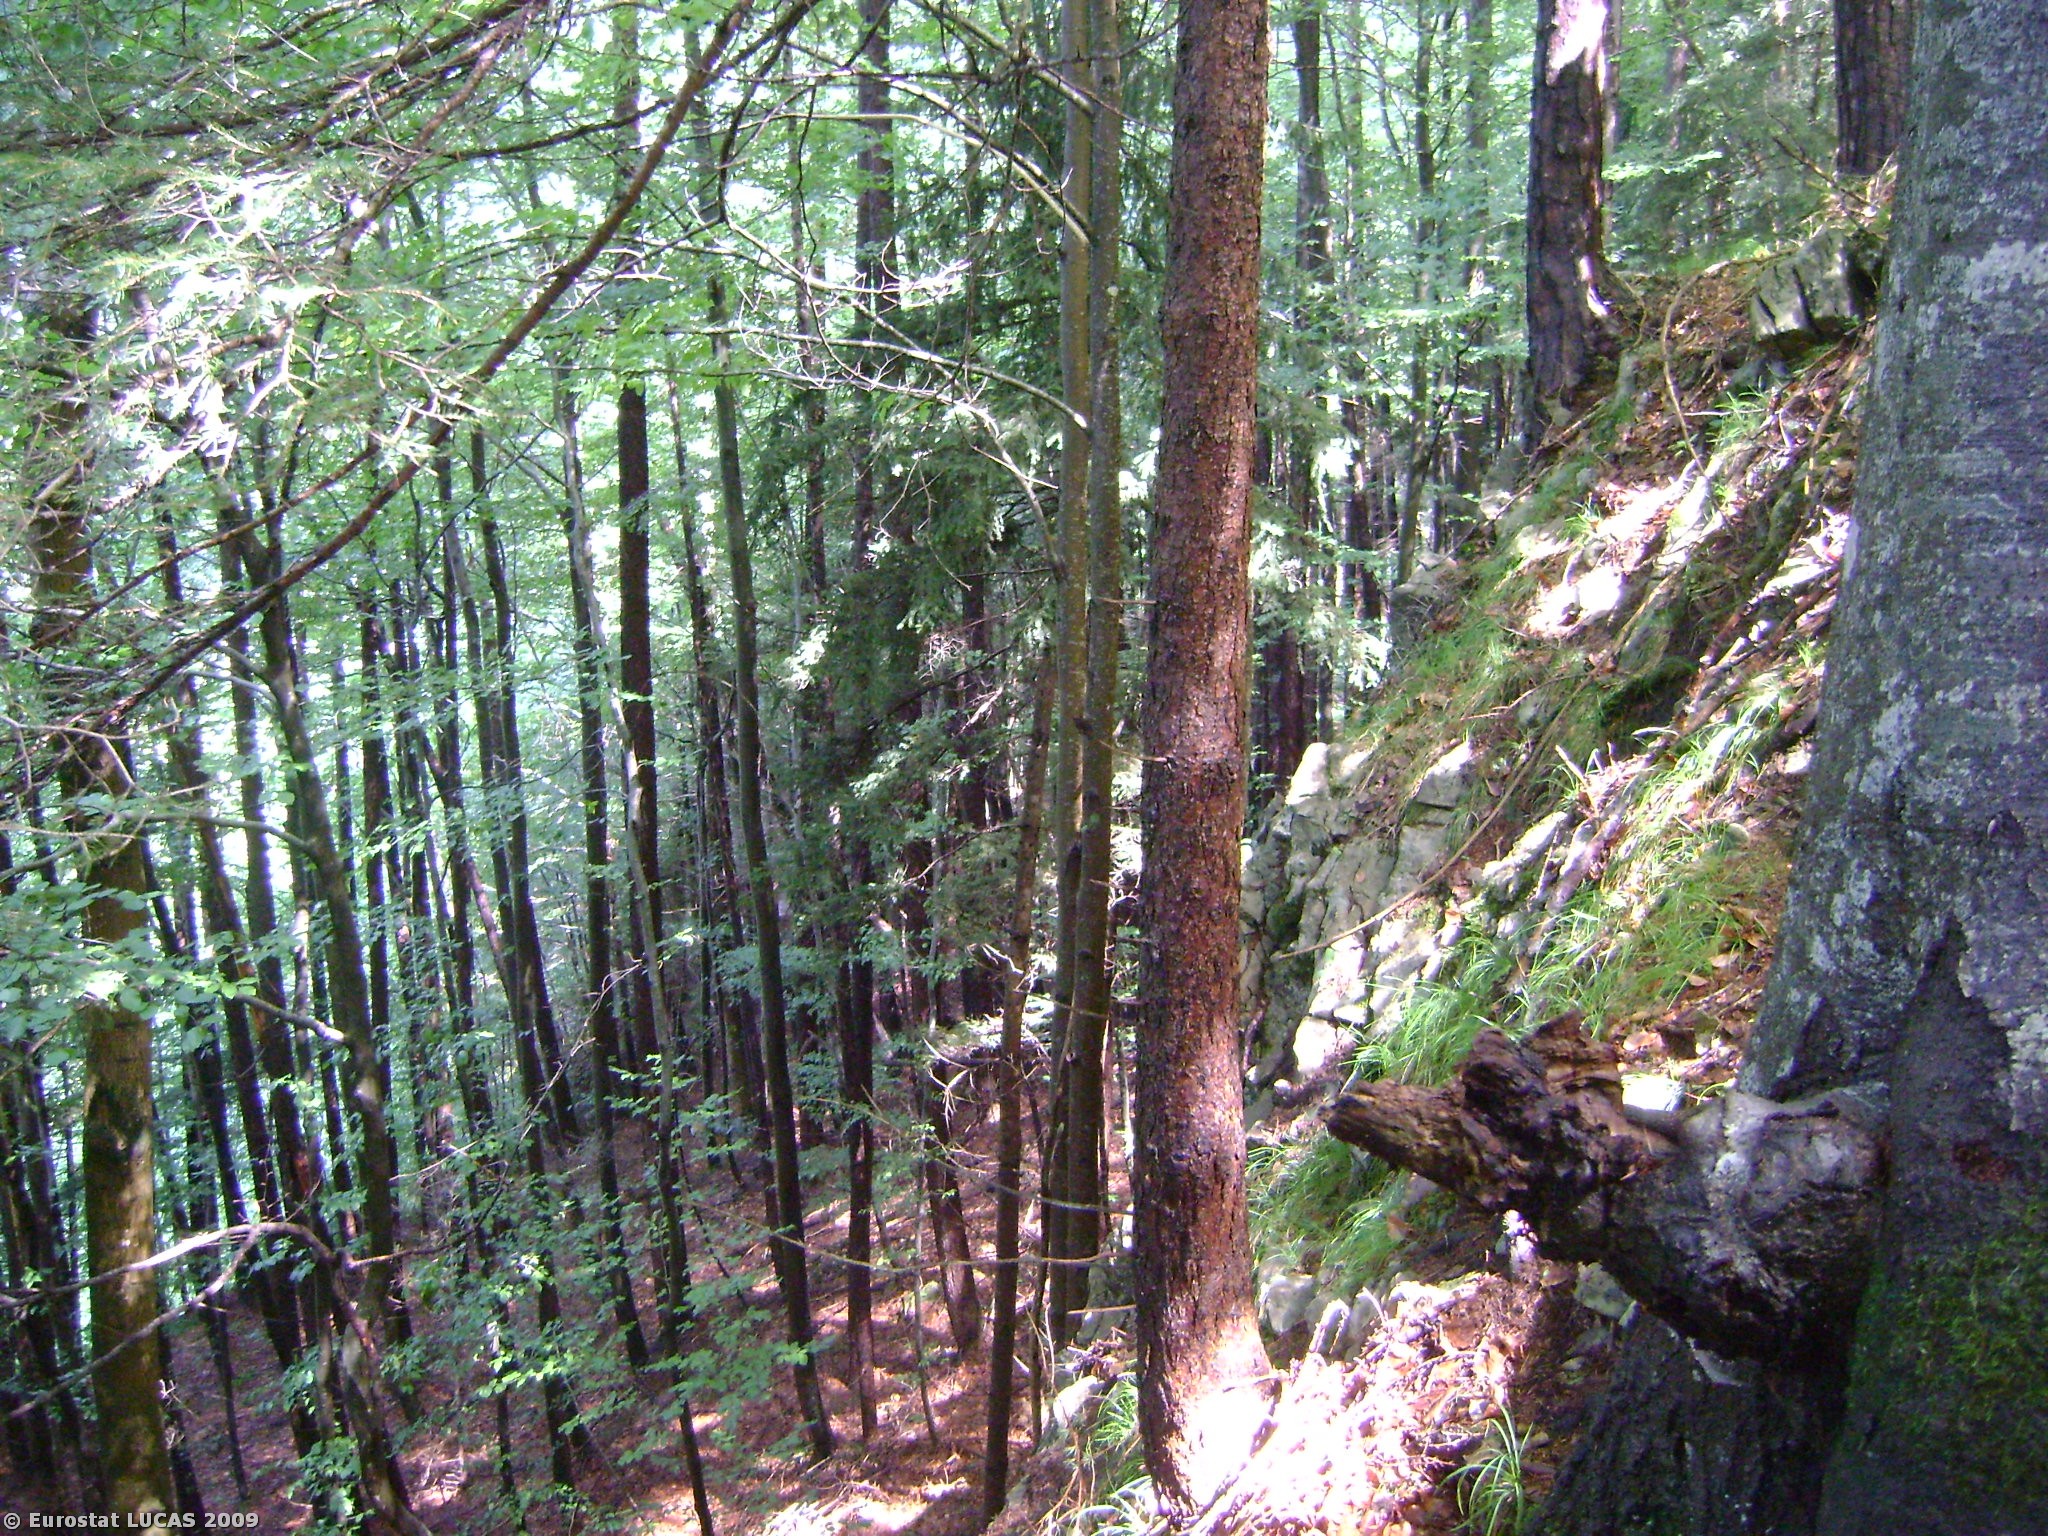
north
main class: Woodland
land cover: Broadleaved woodland
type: beech forest
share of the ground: > 75 %
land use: Forestry
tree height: > 5 m
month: August
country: AT
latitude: 47.3051
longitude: 9.6697
